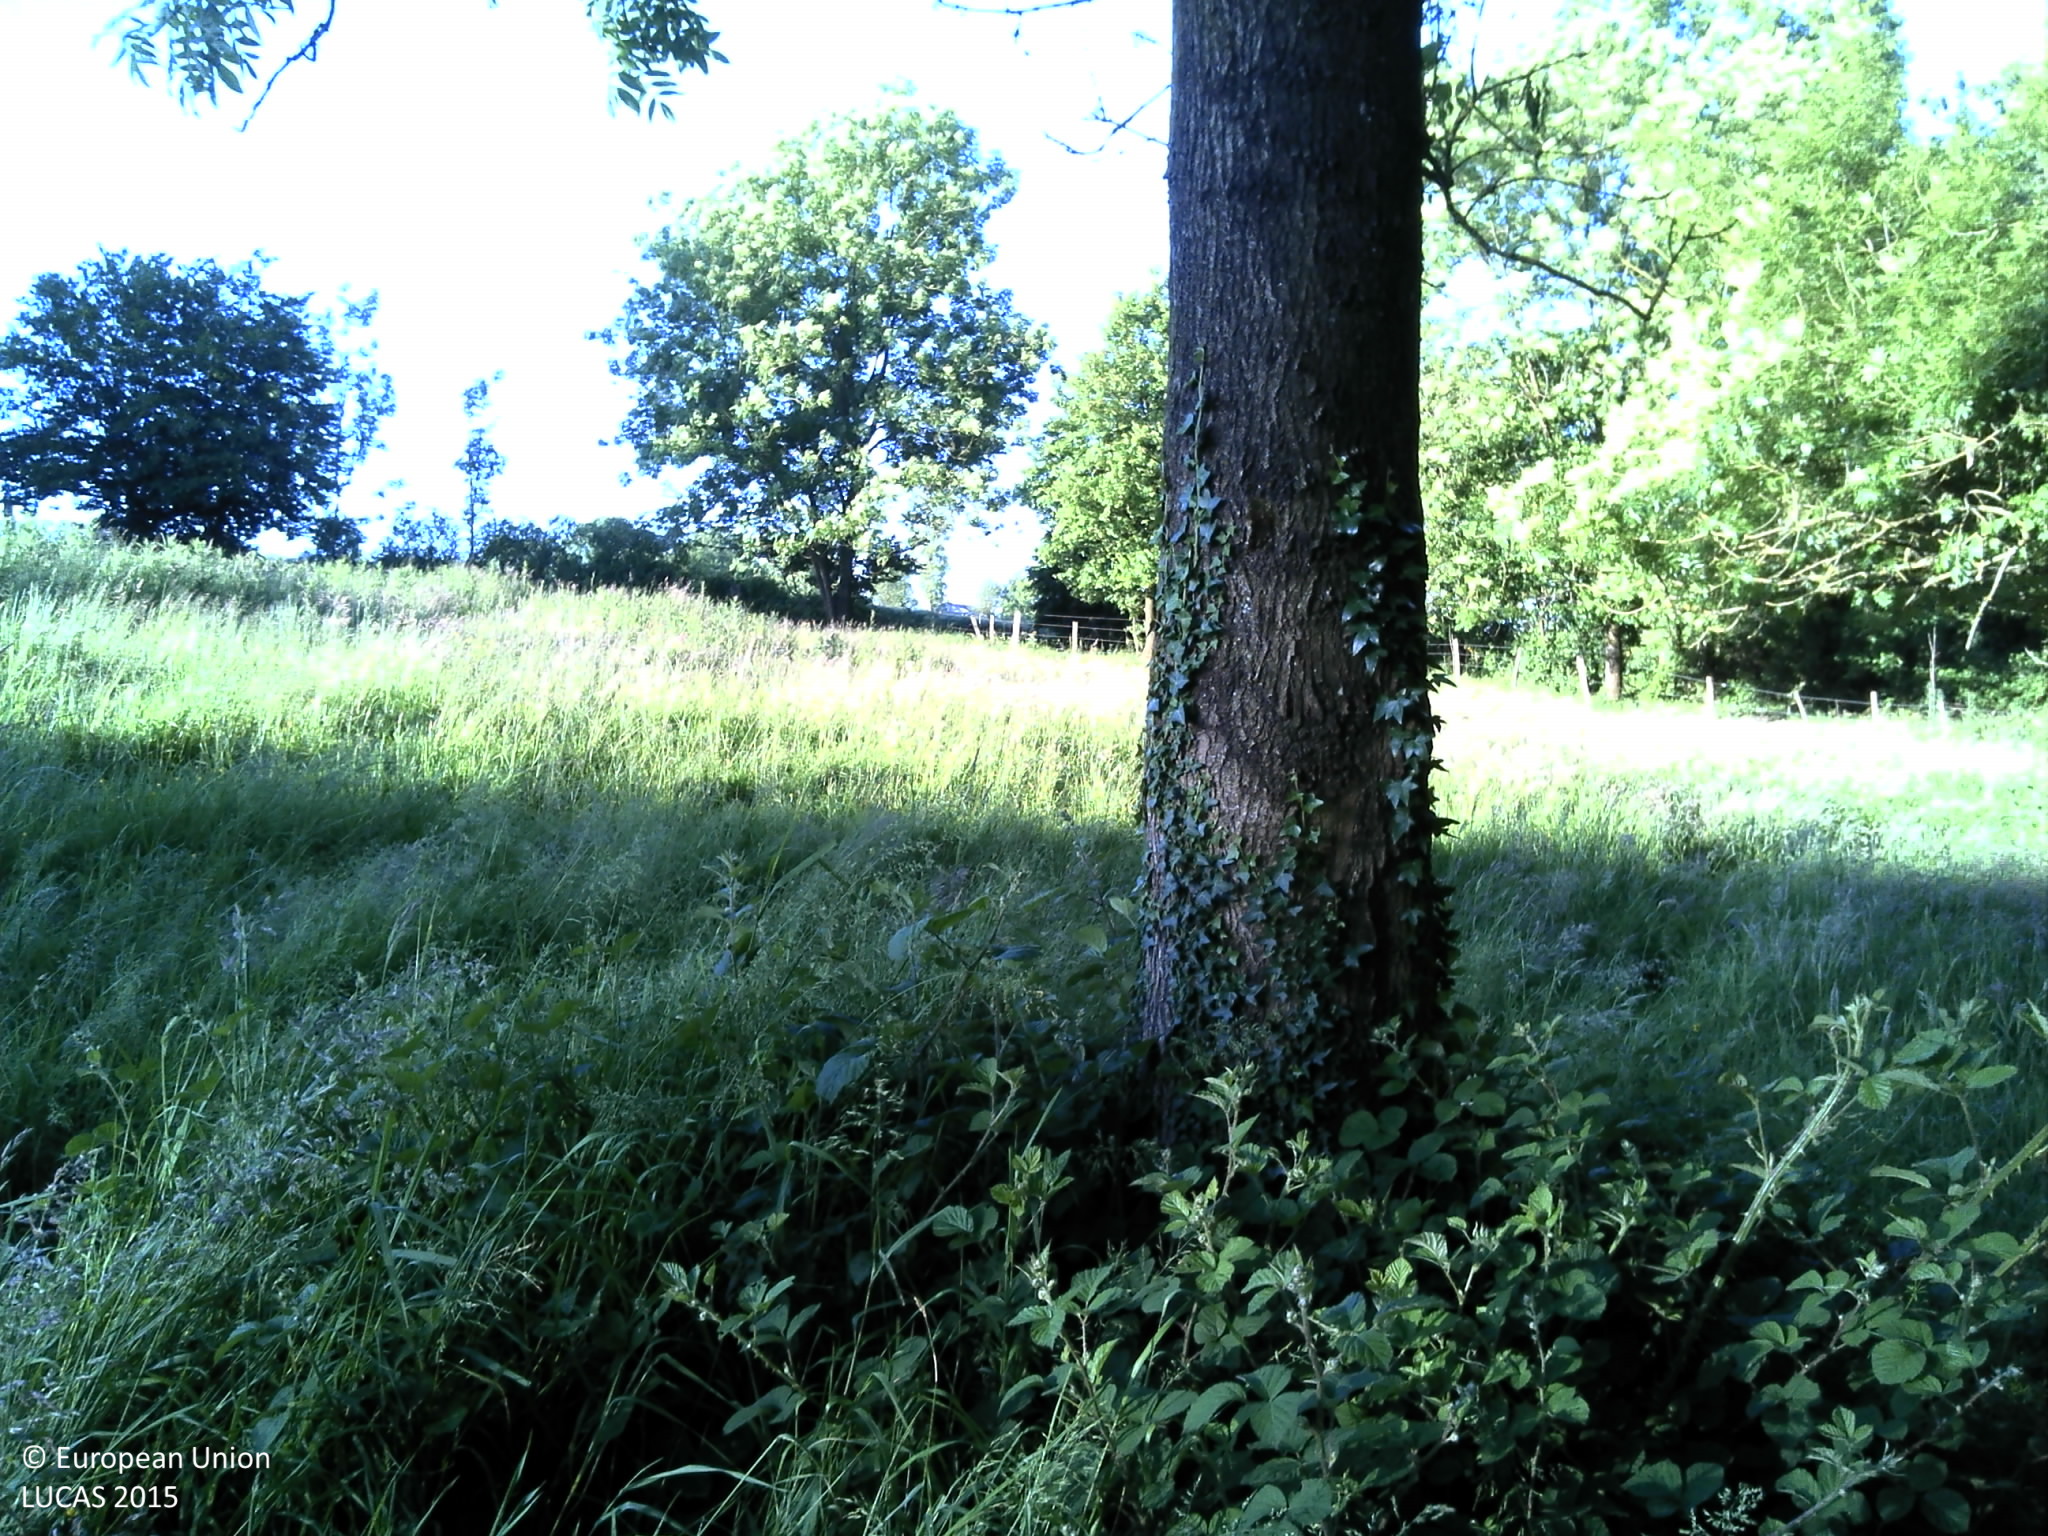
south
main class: Grassland
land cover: Grassland with sparse tree/shrub cover
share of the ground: > 75 %
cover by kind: herbaceous plants 95 %, broadleaved forest trees 5 %
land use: Agriculture (excluding fallow land and kitchen gardens)
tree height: > 5 m
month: June
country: FR
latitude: 49.5902
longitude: 0.9717
